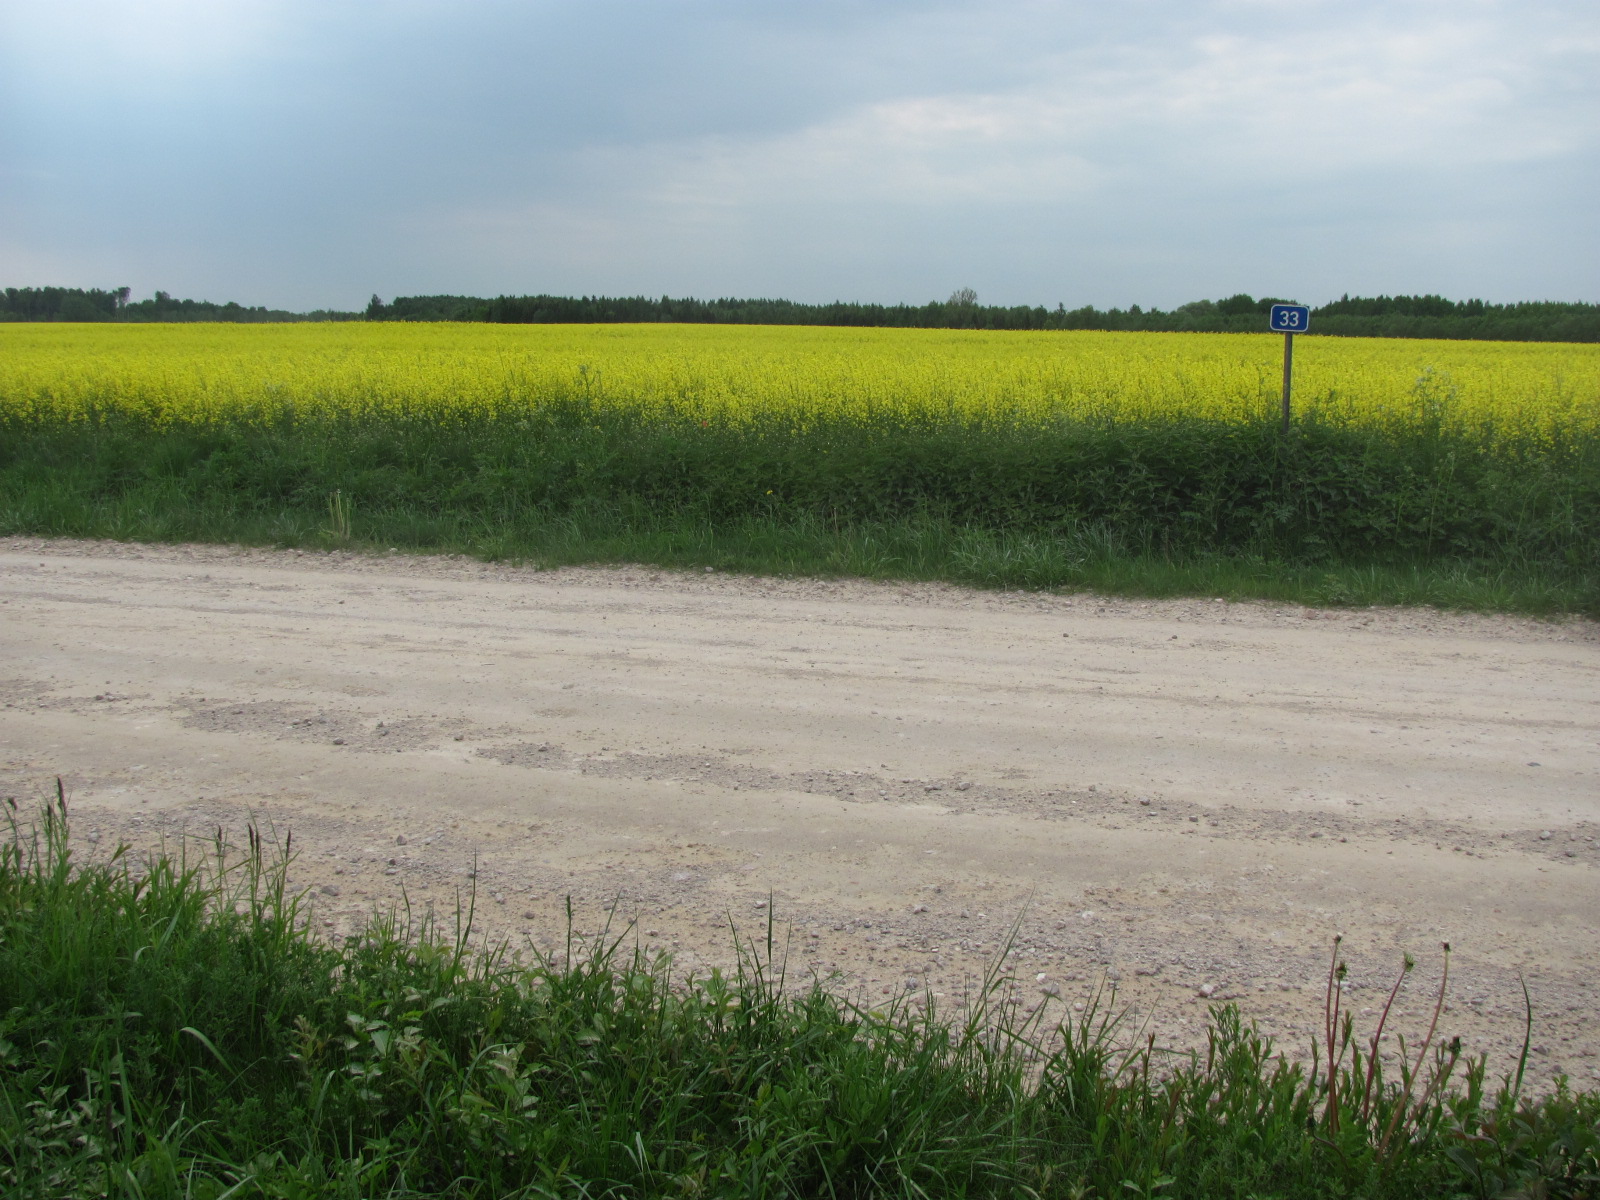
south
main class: Cropland
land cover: Rape and turnip rape
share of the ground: > 75 %
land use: Agriculture (excluding fallow land and kitchen gardens)
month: May
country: LV
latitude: 56.4792
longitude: 24.1325
